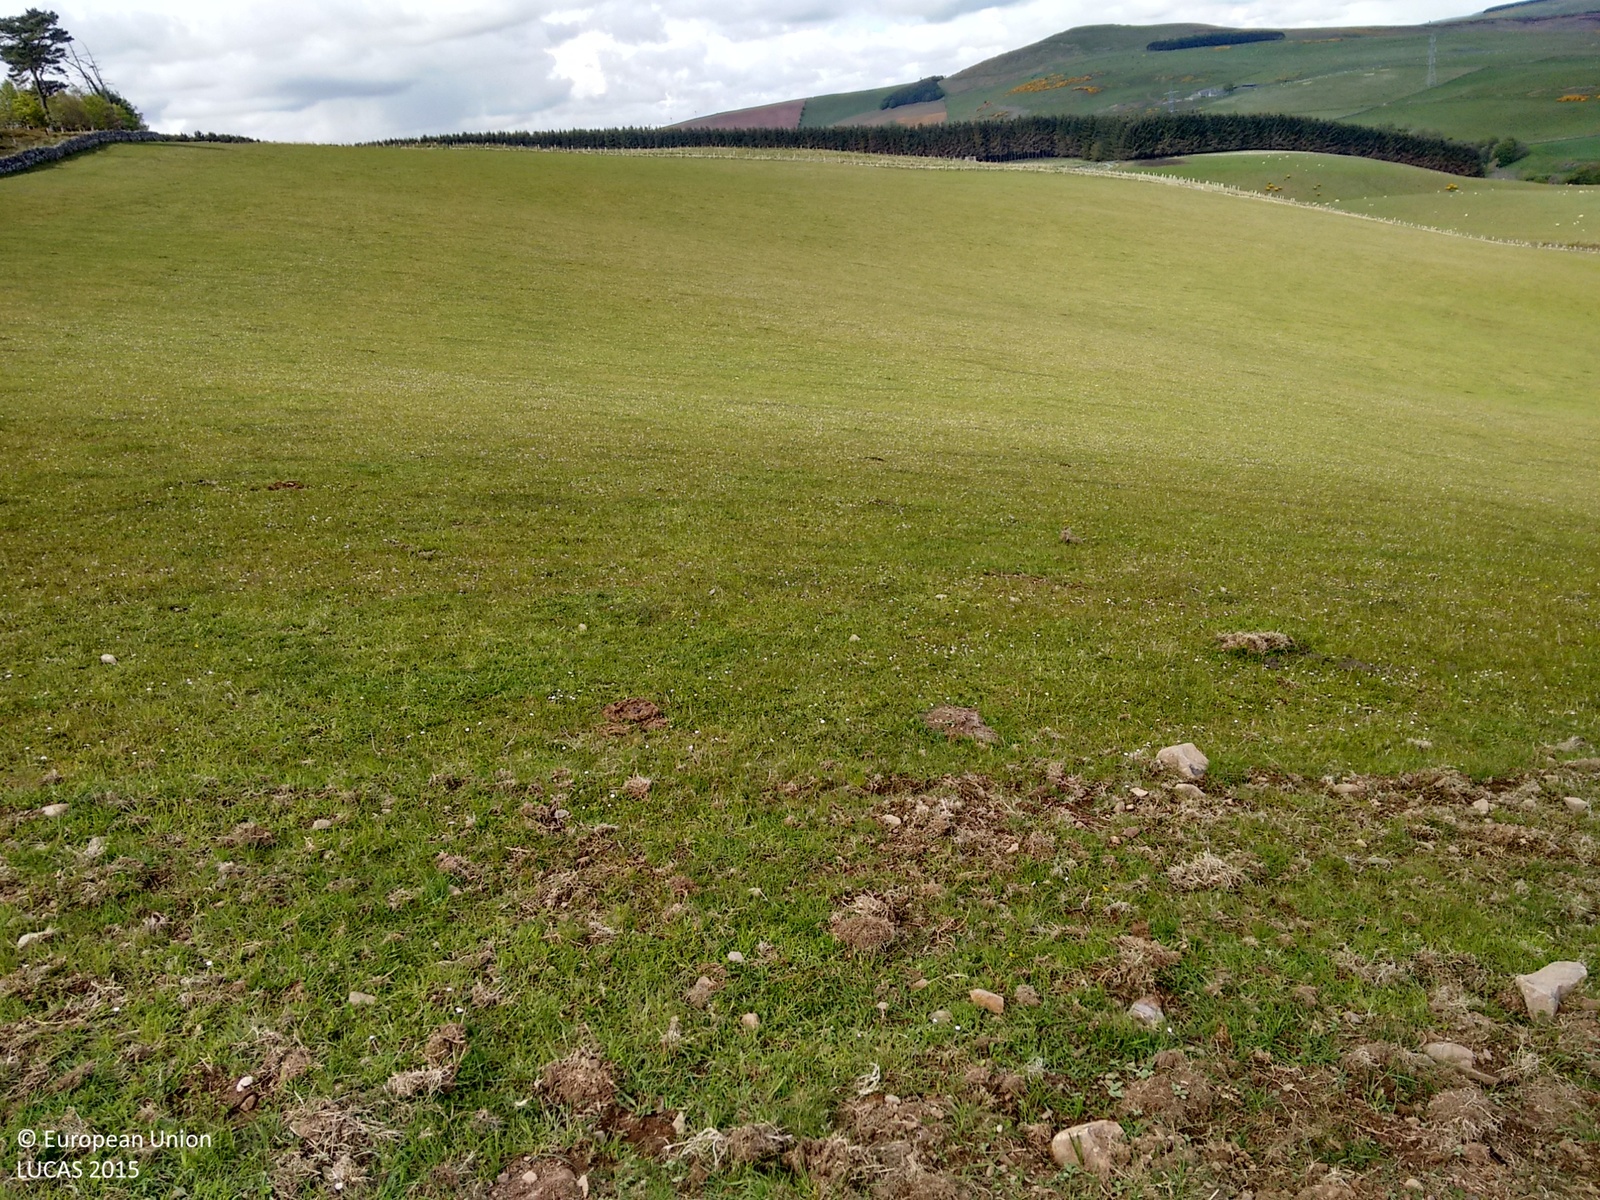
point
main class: Grassland
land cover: Grassland without tree/shrub cover
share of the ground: > 75 %
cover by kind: herbaceous plants 100 %
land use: Agriculture (excluding fallow land and kitchen gardens)
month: May
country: GB
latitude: 55.8268
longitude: -2.3329
